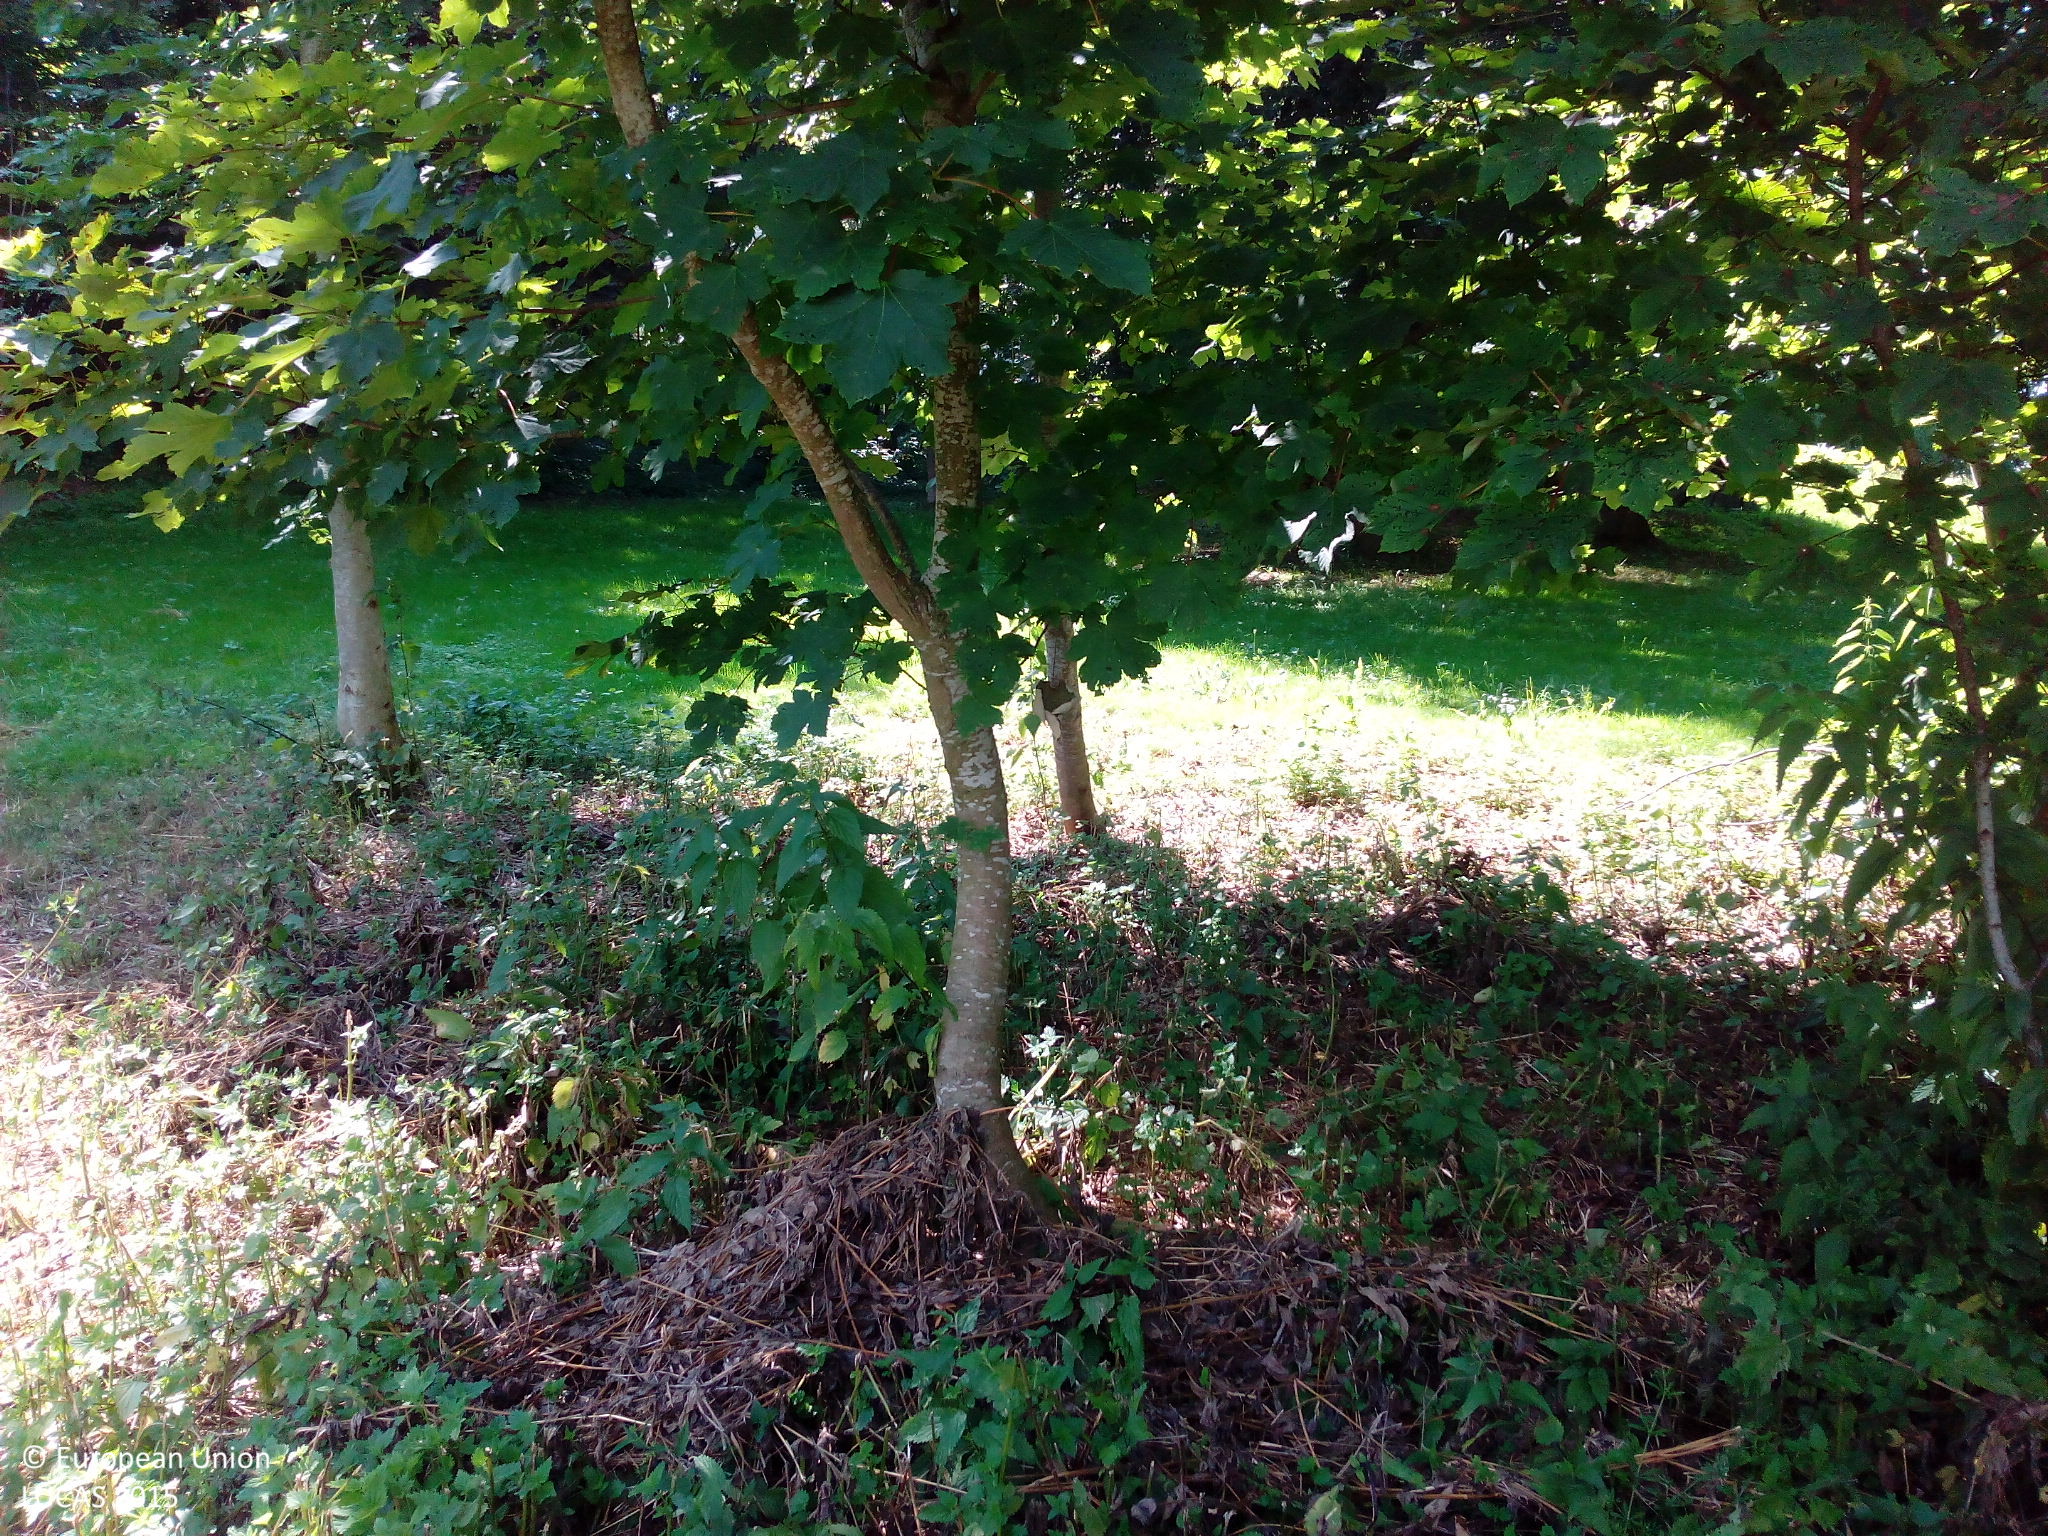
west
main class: Woodland
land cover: Broadleaved woodland
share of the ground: 50 - 75 %
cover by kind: broadleaved forest trees 50 %, herbaceous plants 45 %, shrubs 5 %
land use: Semi-natural and natural areas not in use
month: July
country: DE
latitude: 48.4389
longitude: 9.6352
